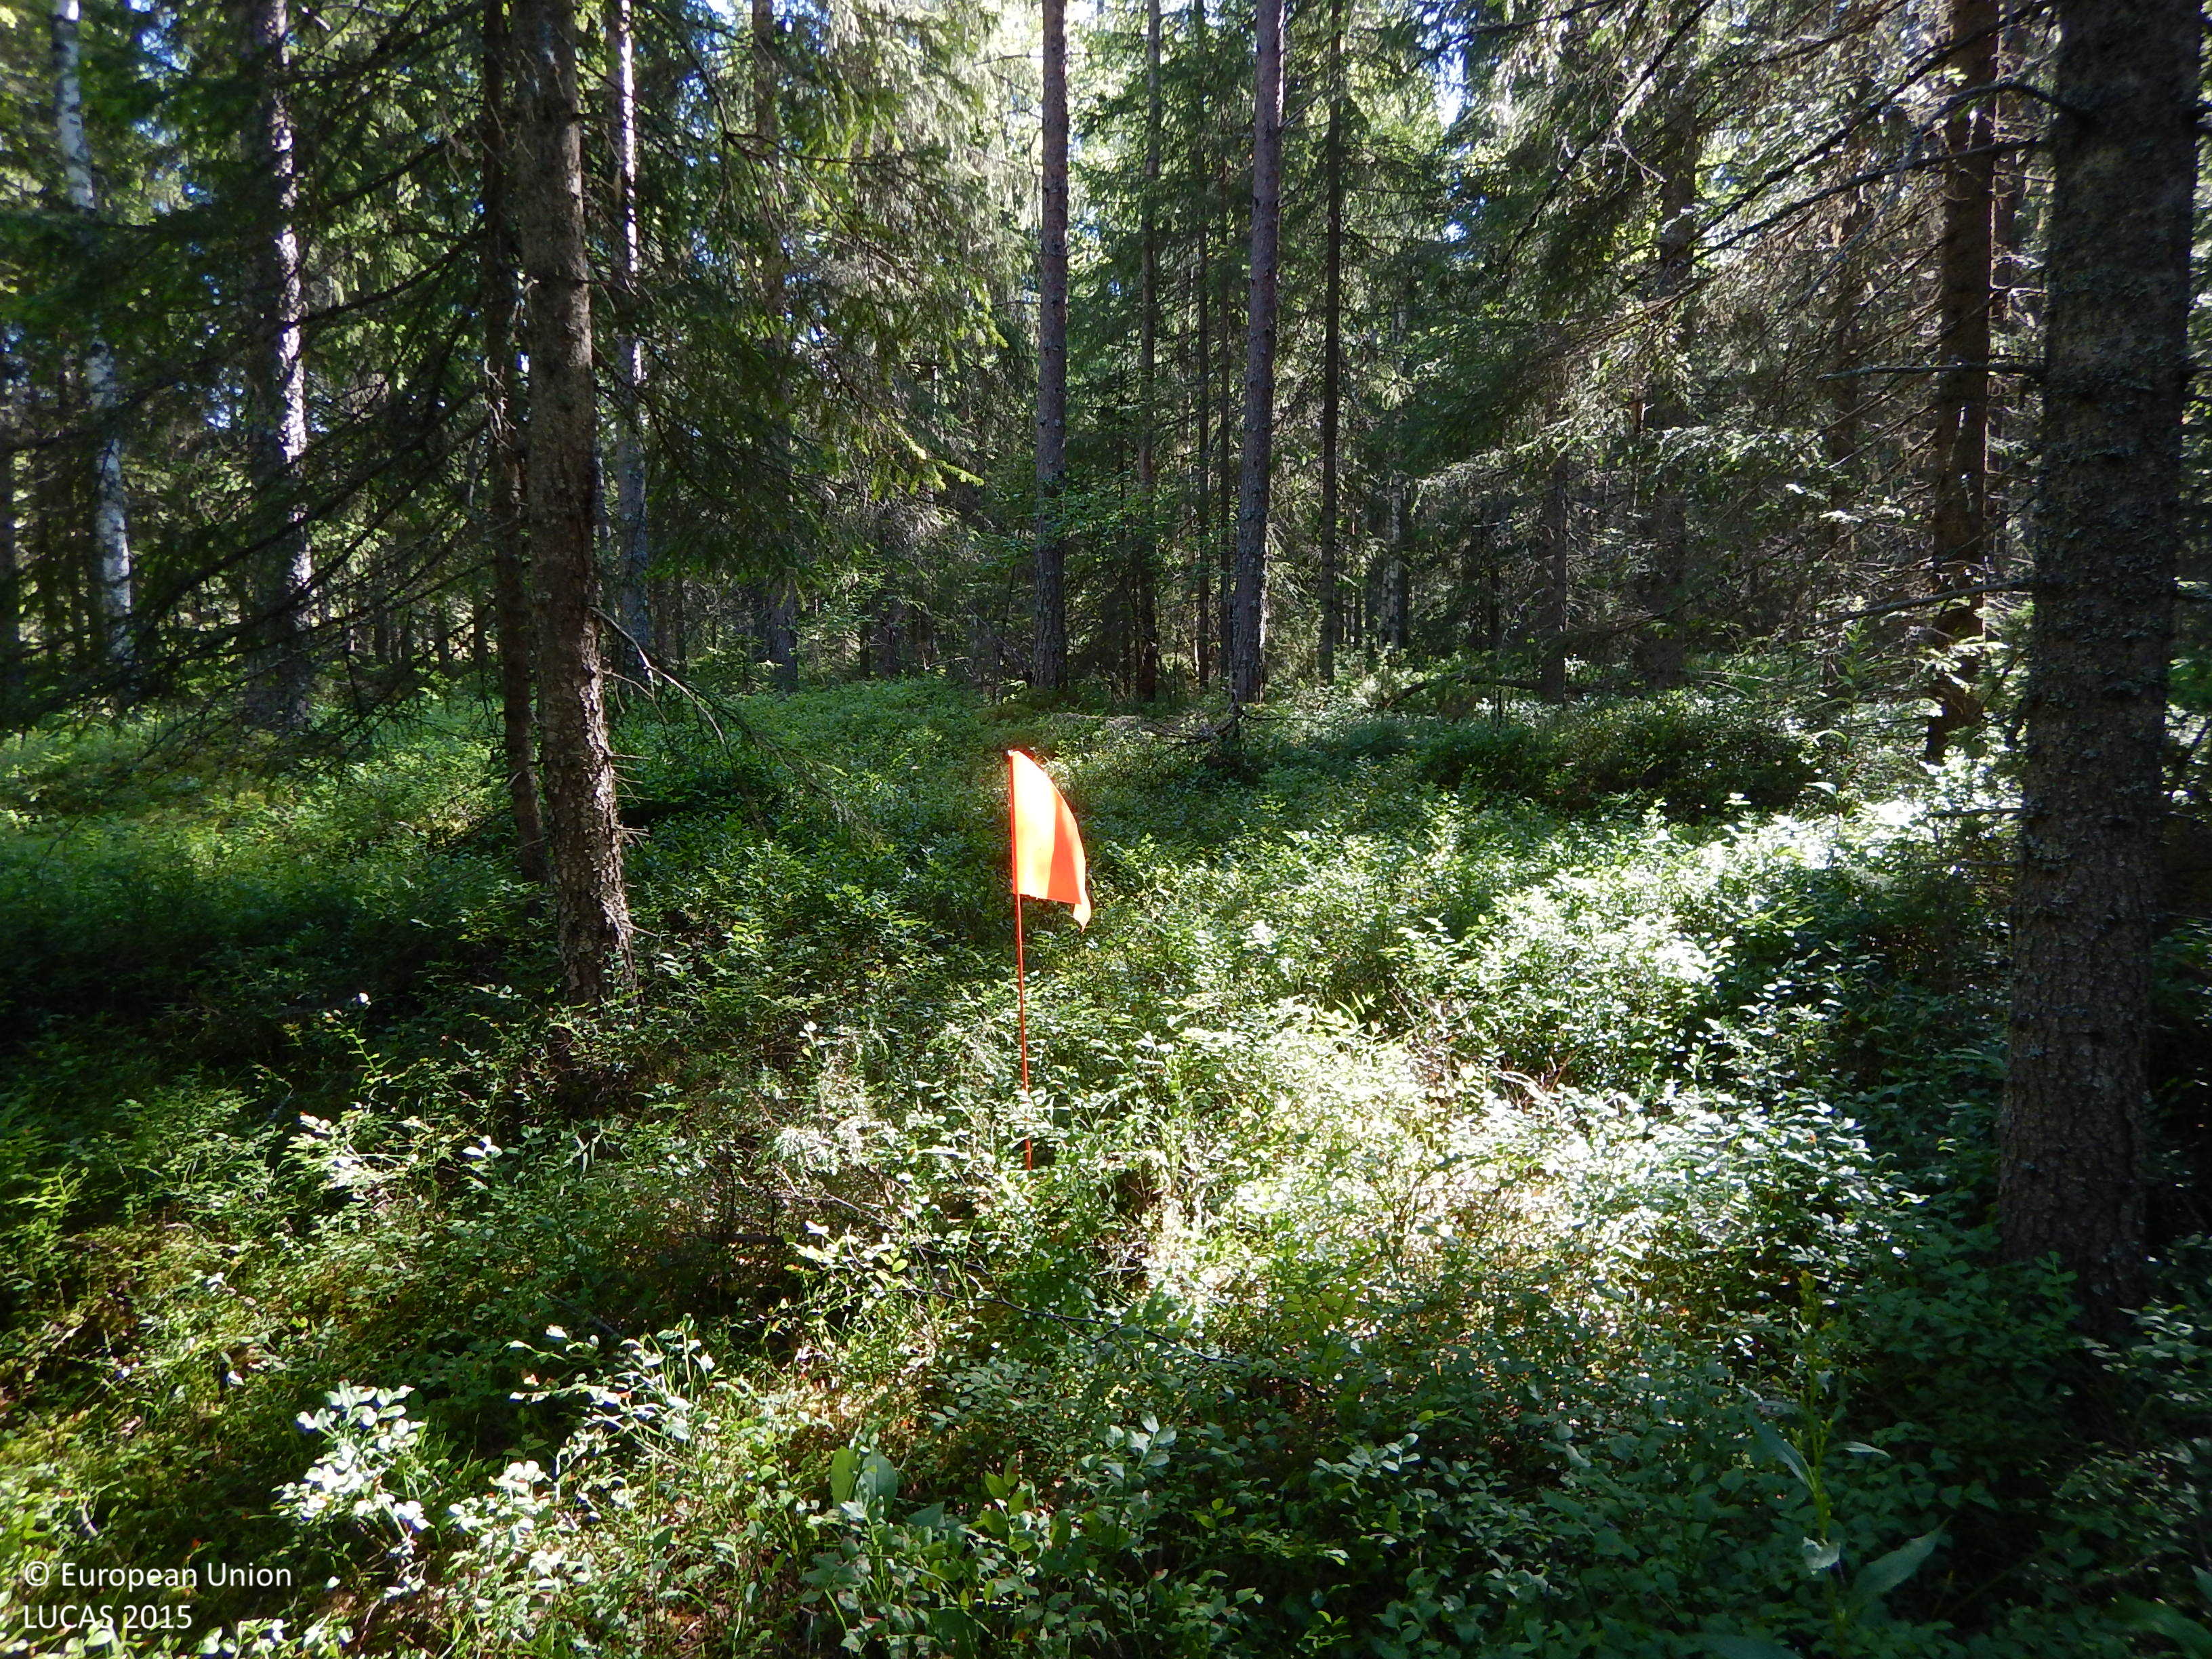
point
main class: Woodland
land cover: Spruce dominated mixed woodland
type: boreal forest
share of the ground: 50 - 75 %
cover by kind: coniferous forest trees 50 %, broadleaved forest trees 20 %, shrubs 15 %, herbaceous plants 10 %, lichens and mosses 5 %
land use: Forestry
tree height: > 5 m
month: July
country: SE
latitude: 64.8221
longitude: 20.9530
